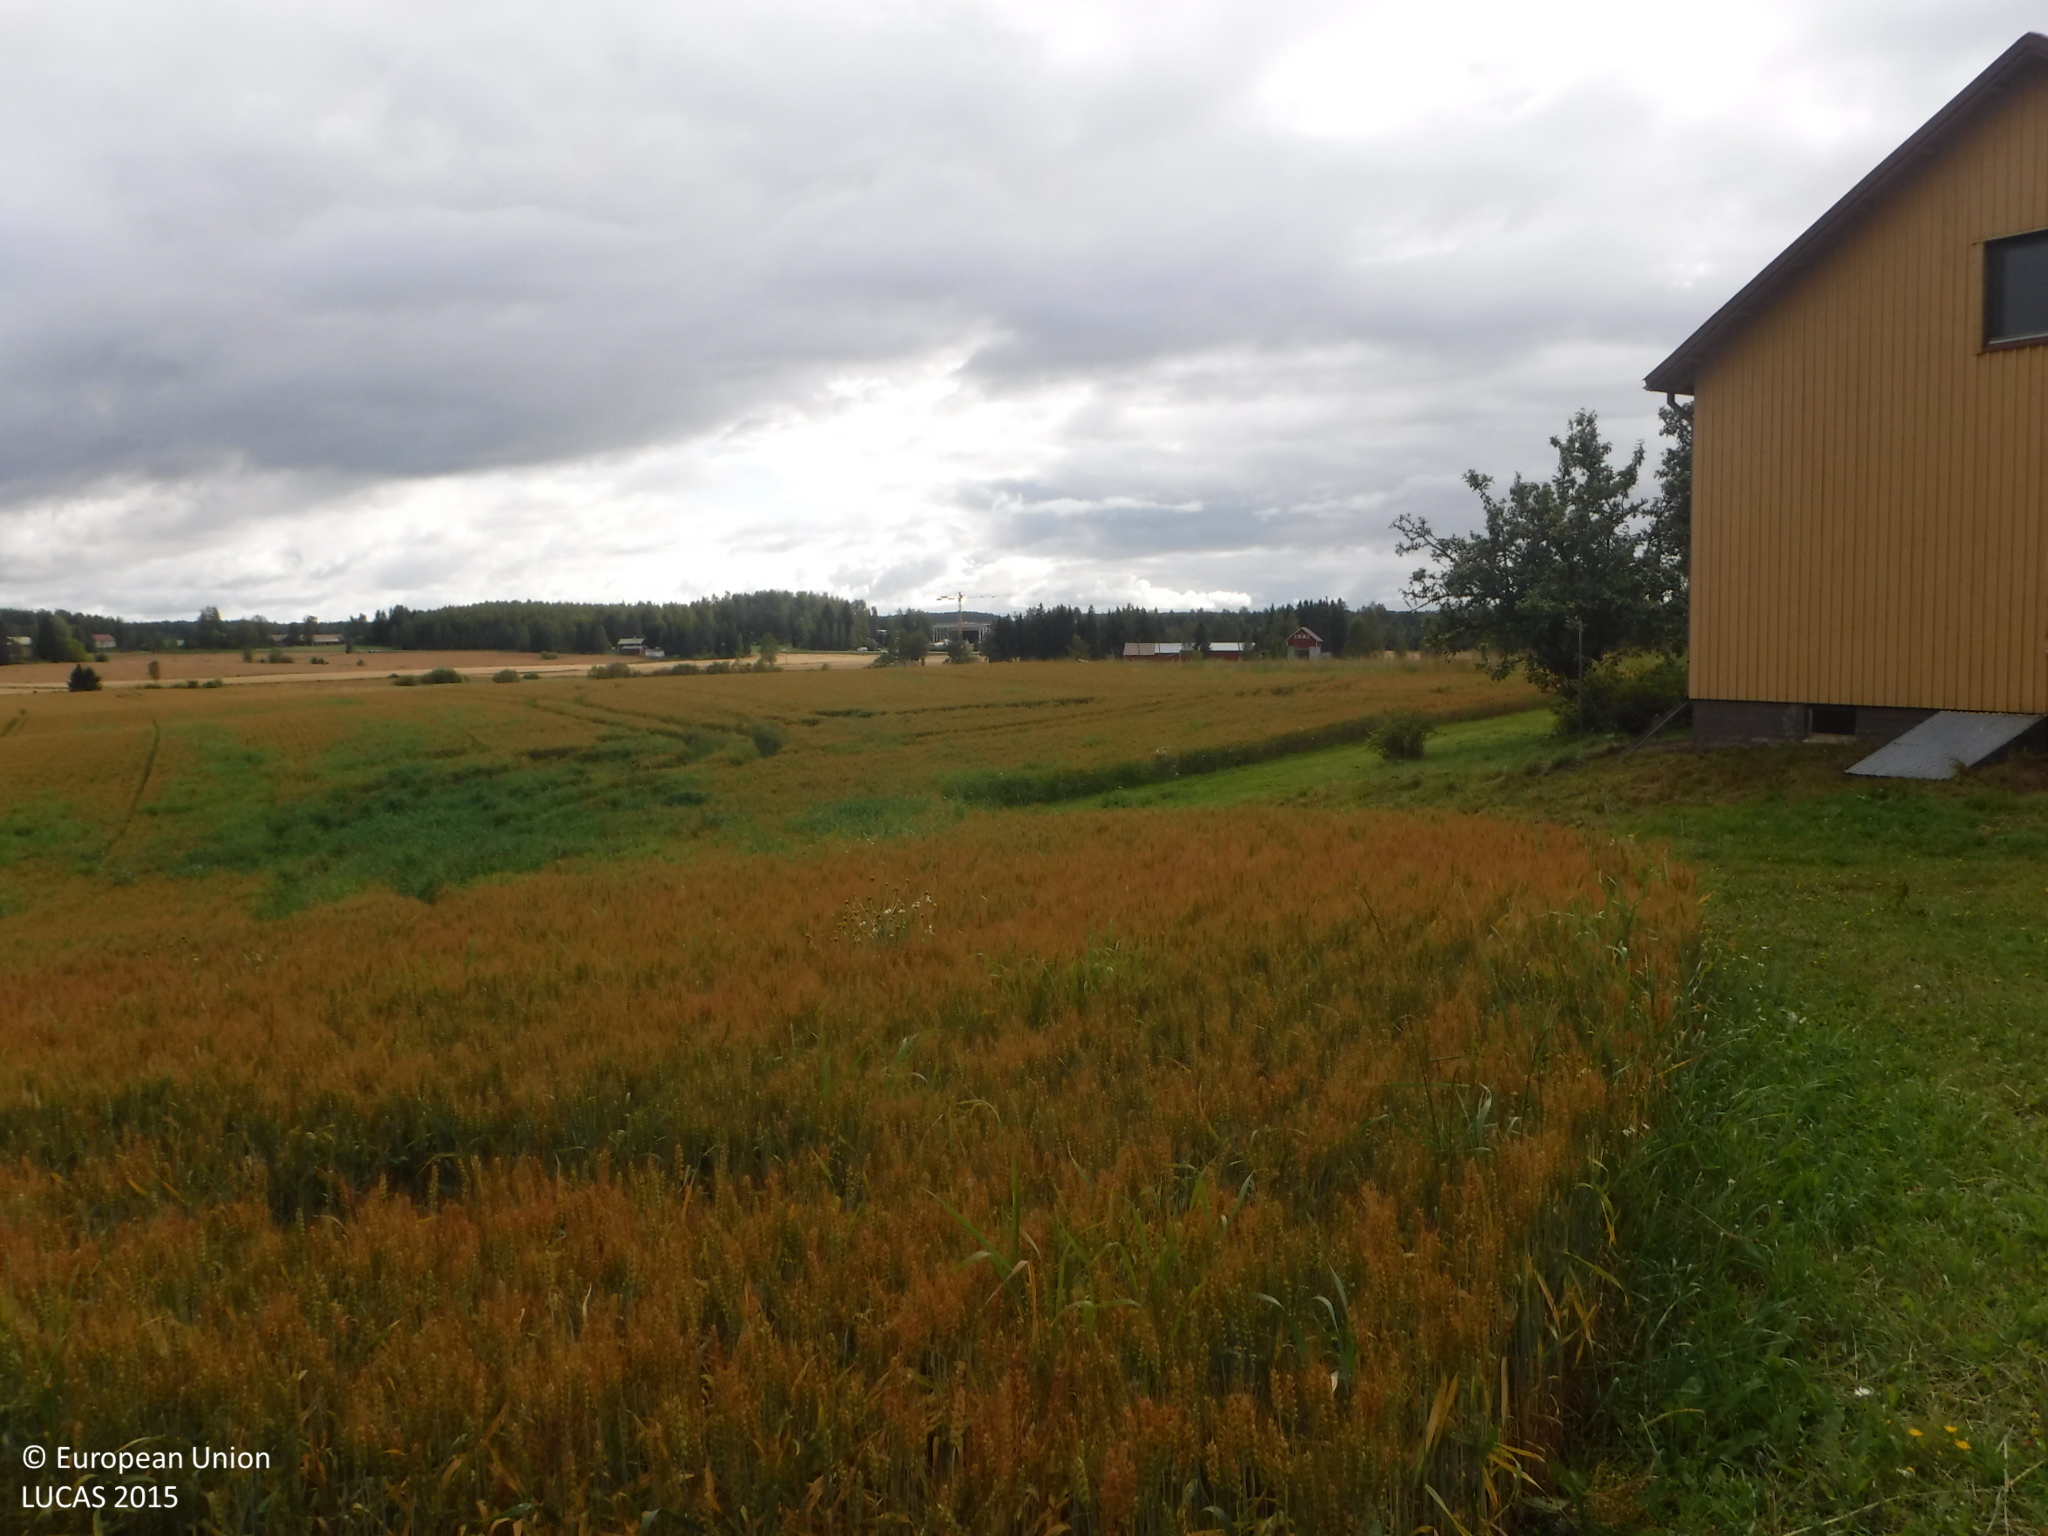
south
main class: Cropland
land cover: Common wheat
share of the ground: > 75 %
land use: Agriculture (excluding fallow land and kitchen gardens)
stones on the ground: < 10 %
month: September
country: FI
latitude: 61.3408
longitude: 23.1017
